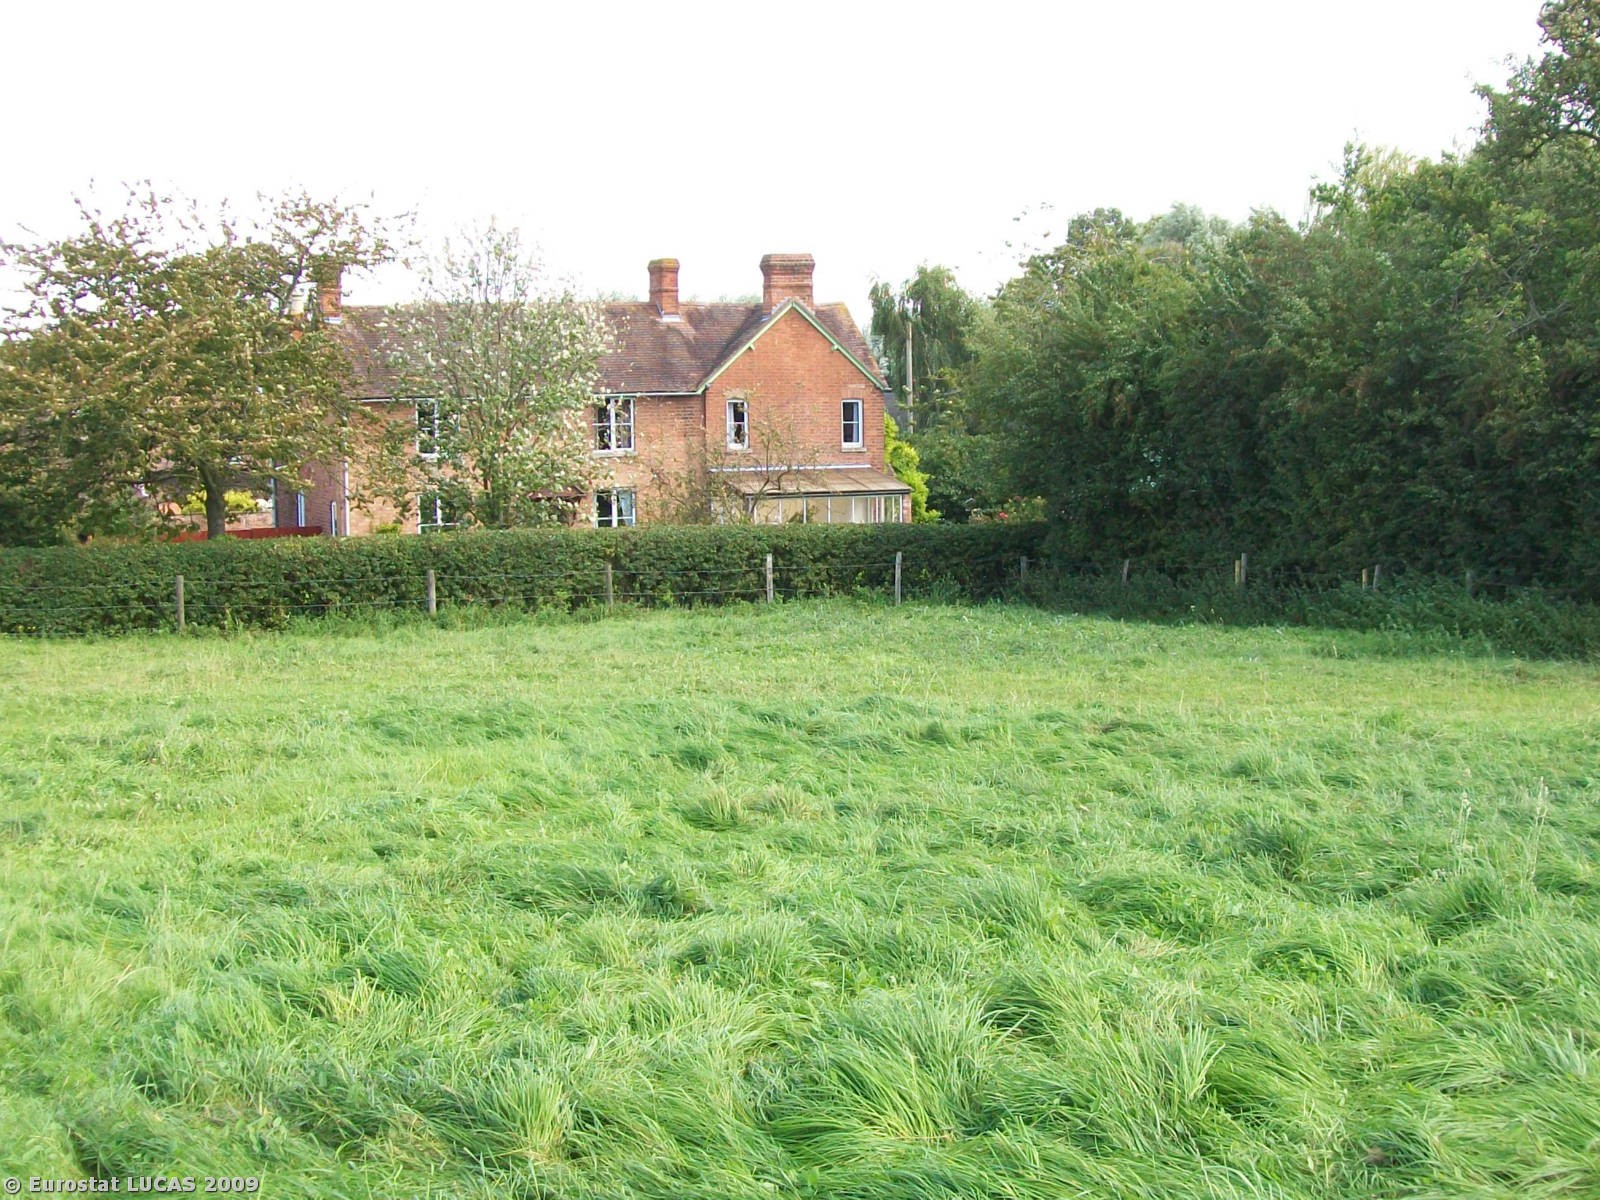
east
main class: Grassland
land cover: Grassland without tree/shrub cover
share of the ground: > 75 %
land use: Agriculture (excluding fallow land and kitchen gardens)
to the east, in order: Grassland without tree/shrub cover; Artificial constructions in urban areas; Grassland with sparse tree/shrub cover; Lines of trees; Broadleaved woodland; Artificial constructions; Grassland without tree/shrub cover; Managed hedges; Ditches and canals; Paved roads, cycling and walking lanes; Managed hedges; Apple fruit
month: August
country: GB
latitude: 51.9854
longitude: -2.3388
